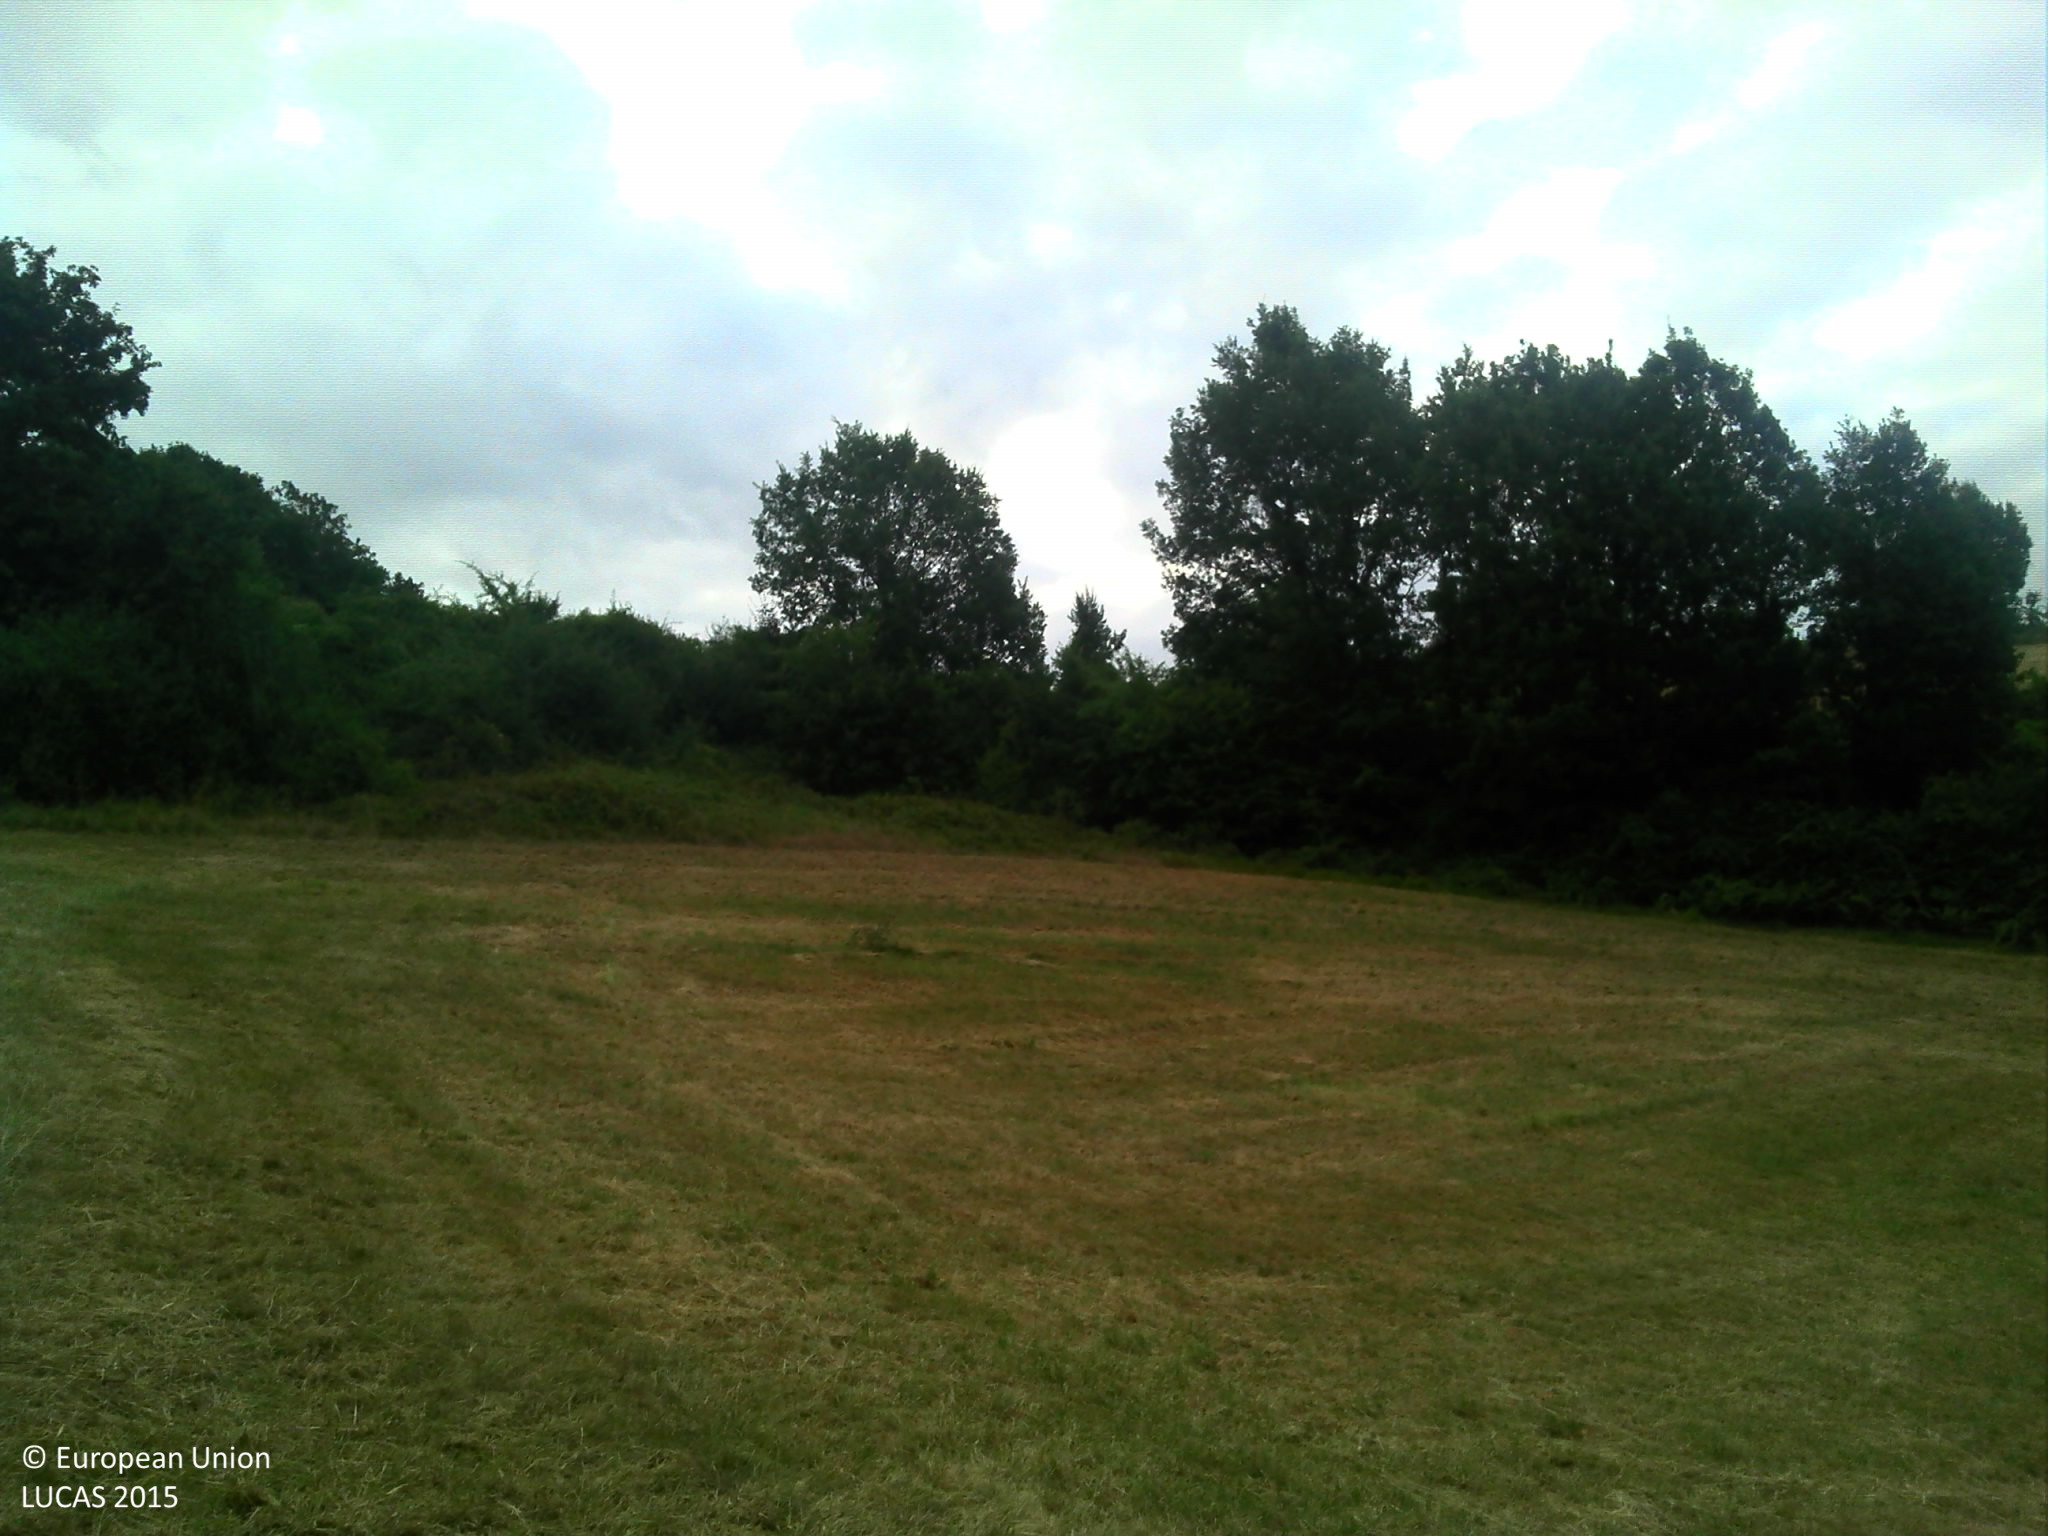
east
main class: Grassland
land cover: Grassland without tree/shrub cover
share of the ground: > 75 %
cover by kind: herbaceous plants 100 %
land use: Agriculture (excluding fallow land and kitchen gardens)
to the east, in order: Grassland without tree/shrub cover; Spontaneously vegetated surfaces; Abandoned hedges; Grassland without tree/shrub cover; Paved roads, cycling and walking lanes; Electric lines; Durum wheat
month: July
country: FR
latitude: 44.2082
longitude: 0.9485
